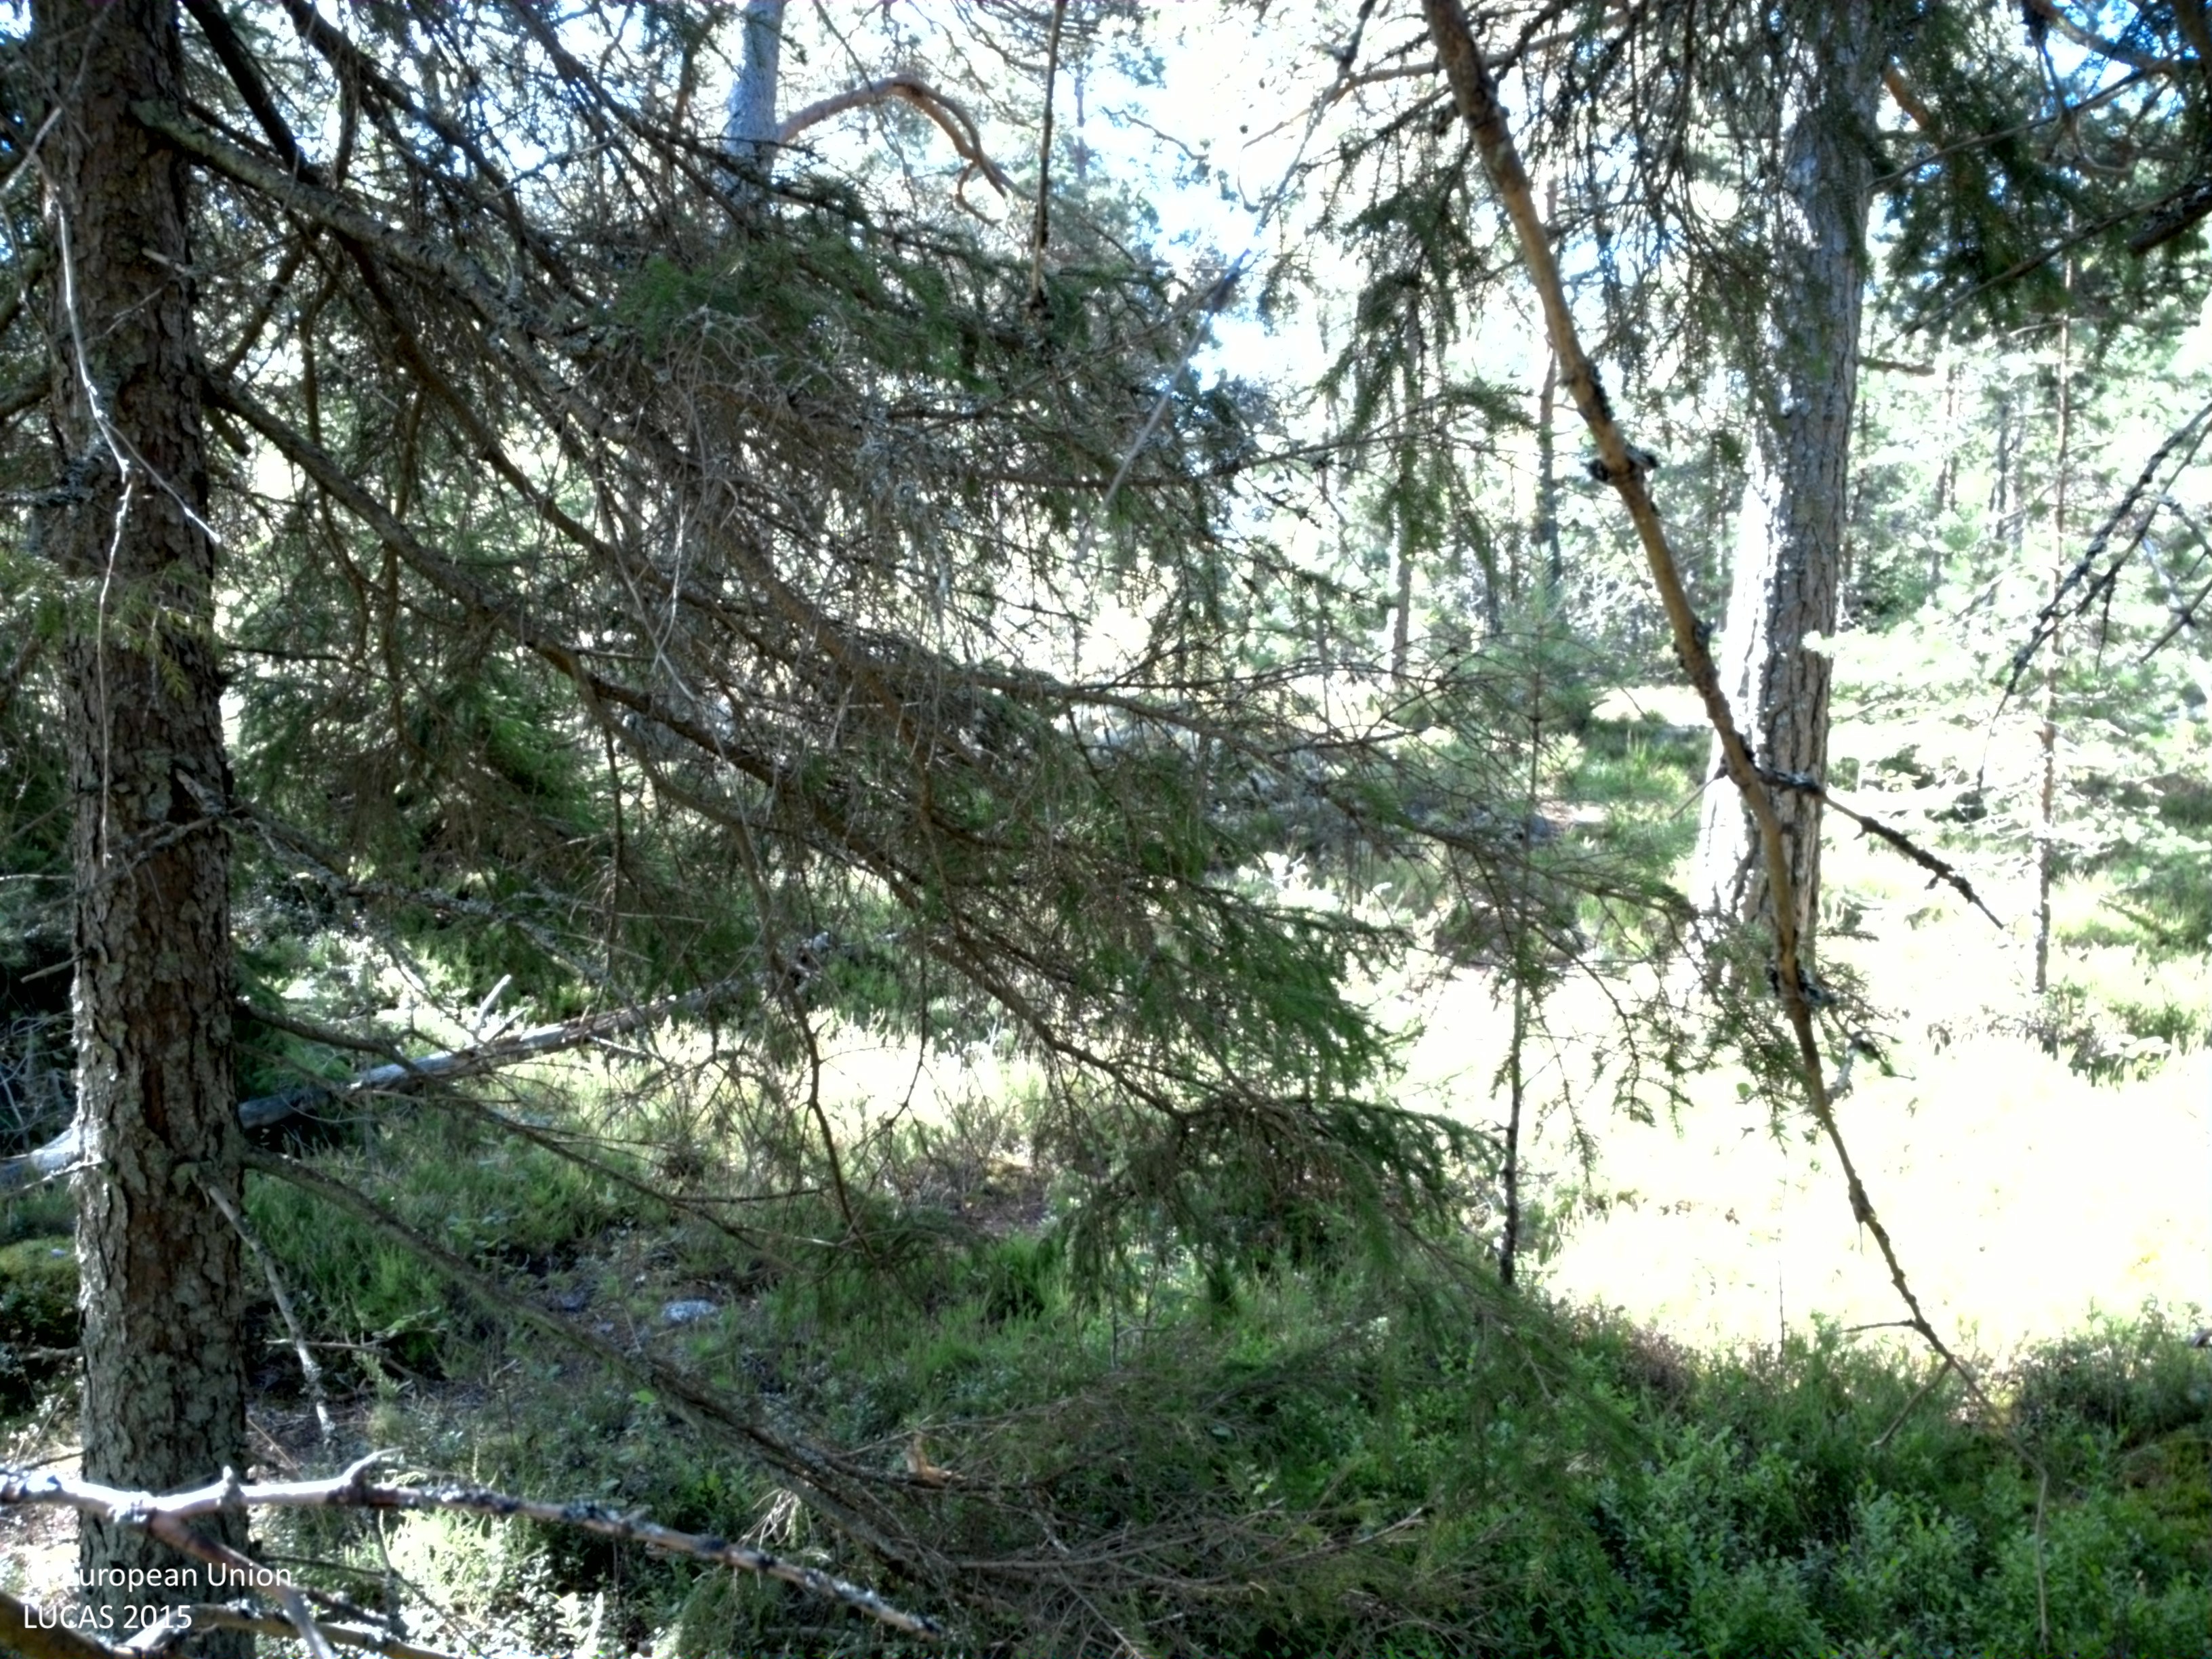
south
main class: Woodland
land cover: Spruce dominated coniferous woodland
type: boreal forest
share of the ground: > 75 %
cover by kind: coniferous forest trees 70 %, lichens and mosses 25 %, broadleaved forest trees 5 %
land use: Forestry
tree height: > 5 m
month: August
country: SE
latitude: 59.5452
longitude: 18.4723
